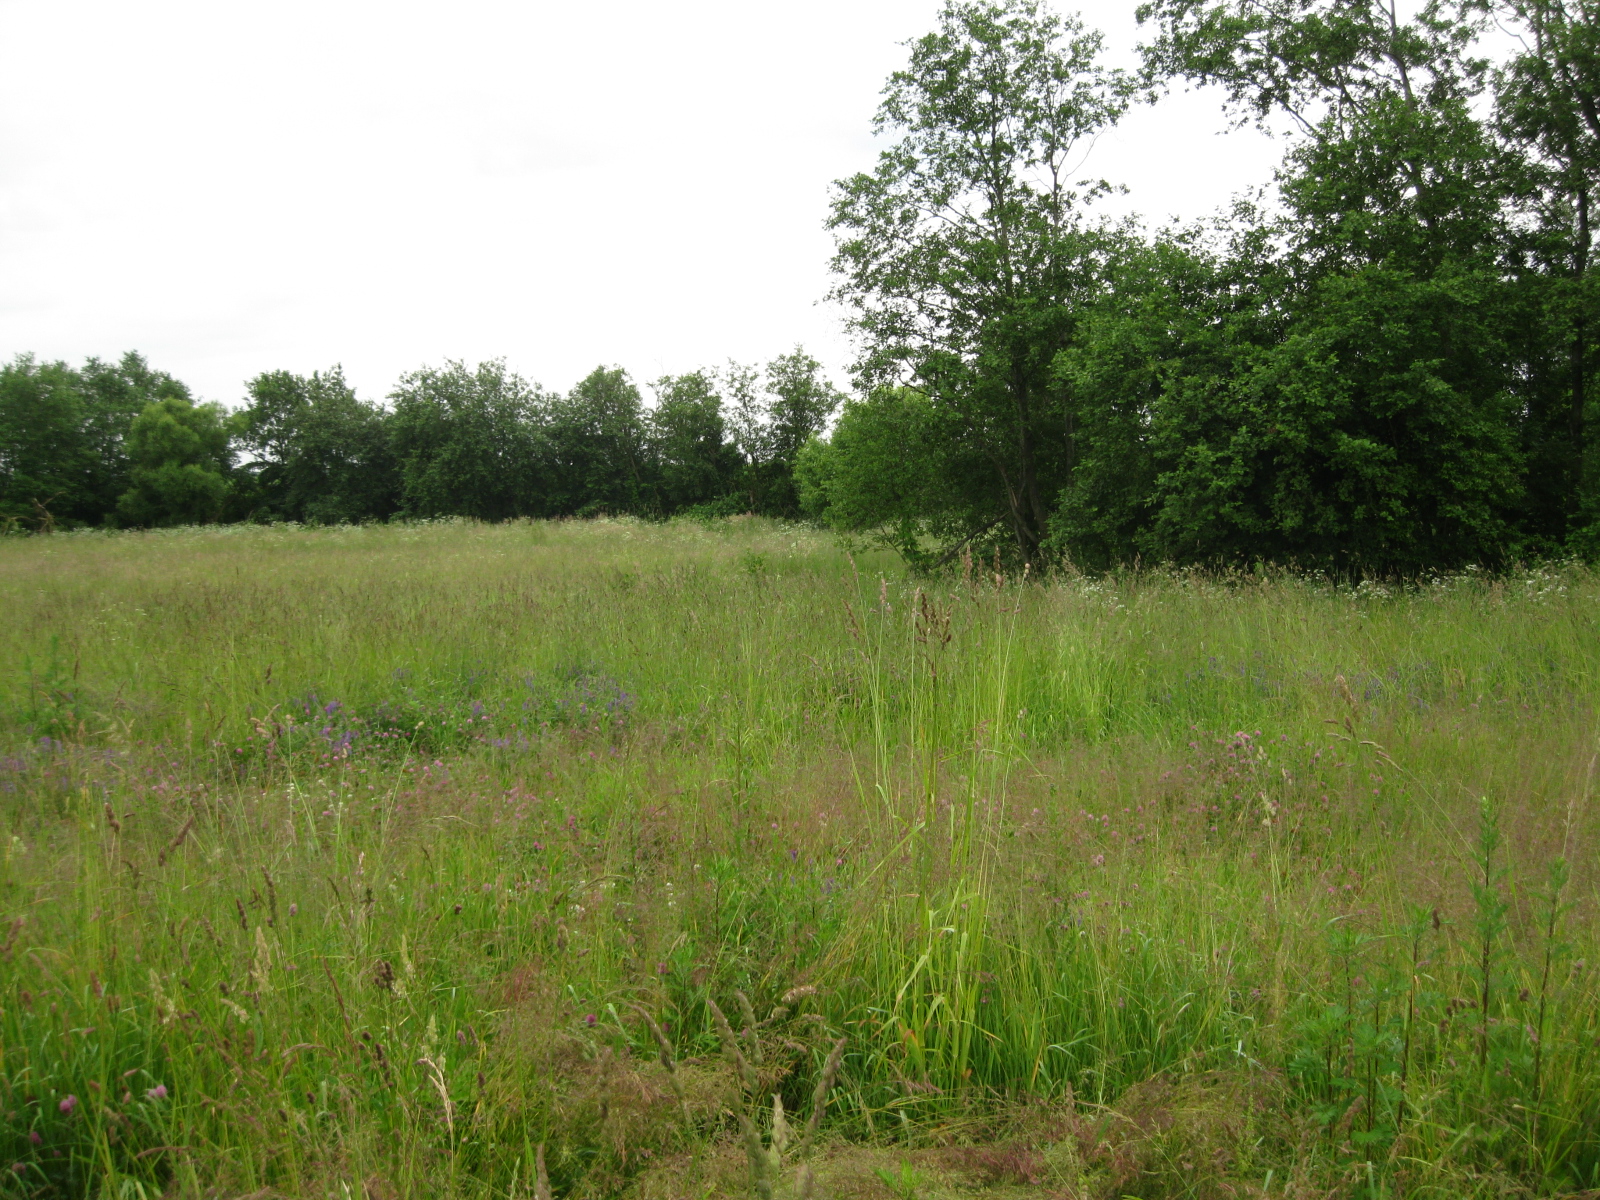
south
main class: Grassland
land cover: Grassland without tree/shrub cover
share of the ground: > 75 %
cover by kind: herbaceous plants 100 %
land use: Agriculture (excluding fallow land and kitchen gardens)
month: June
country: LT
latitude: 55.1894
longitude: 24.0550
